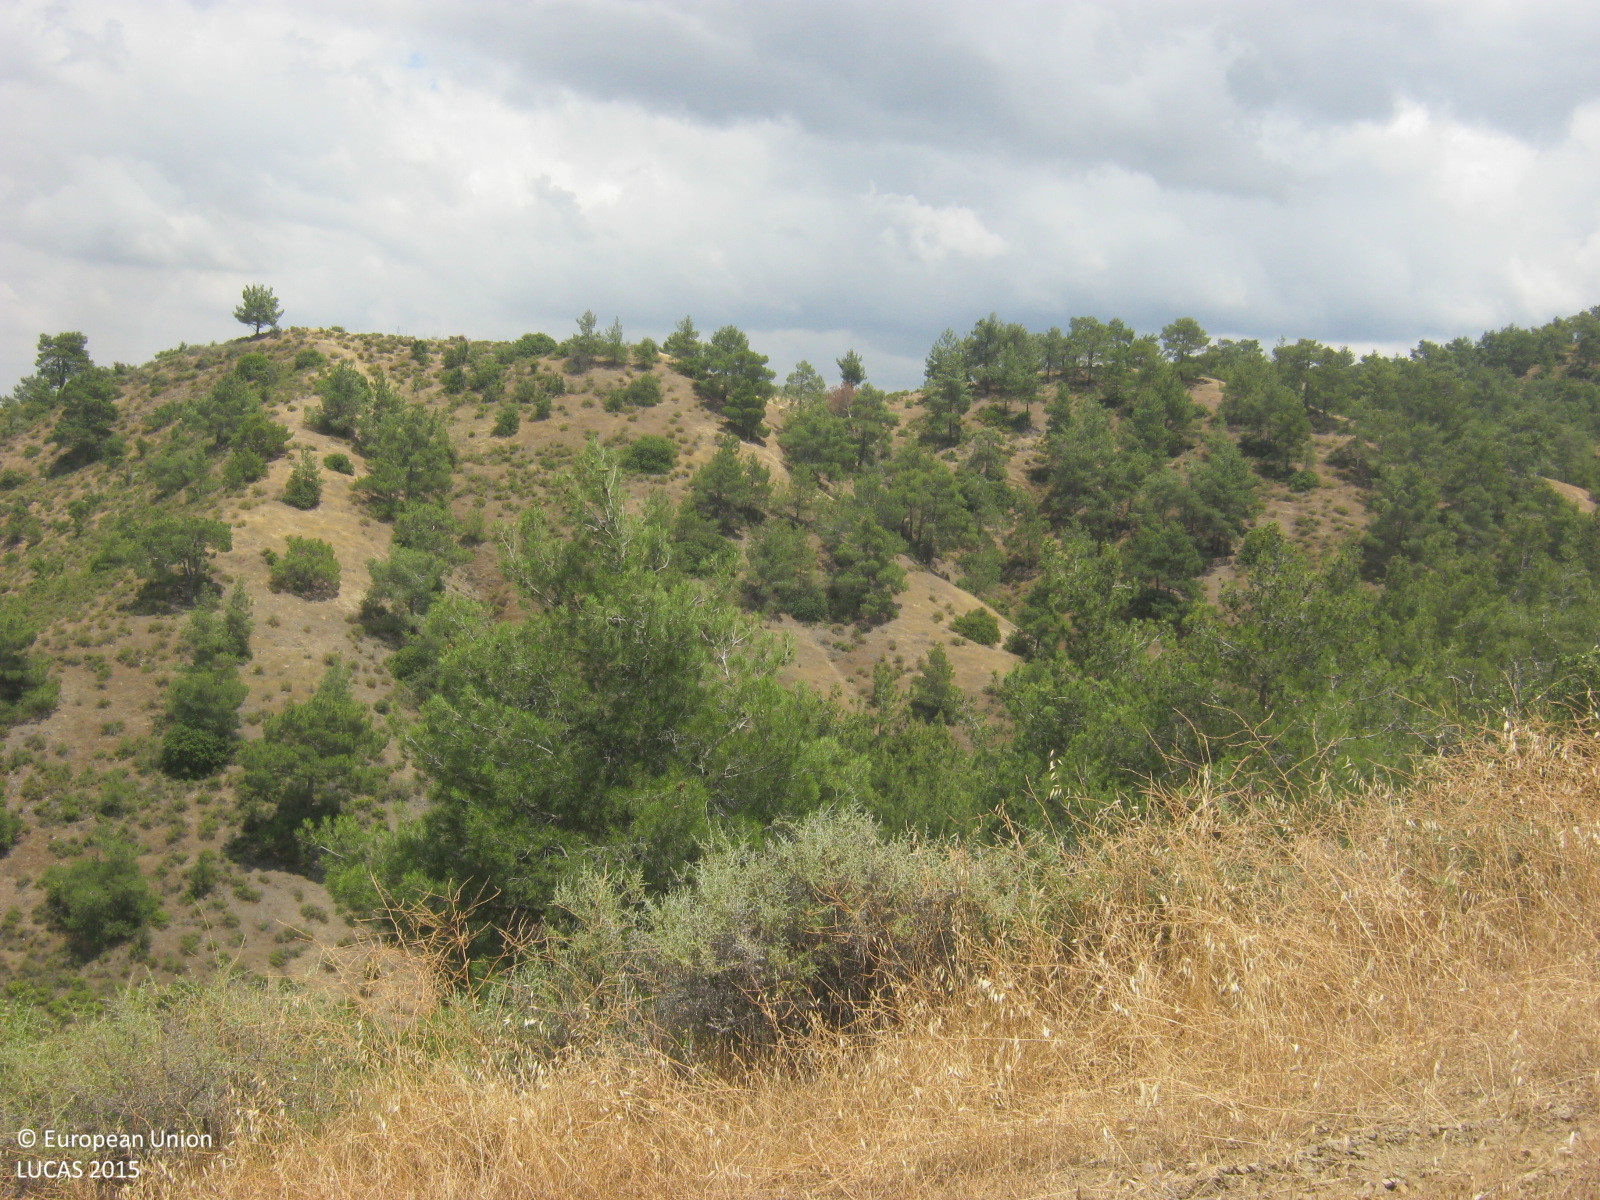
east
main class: Shrubland
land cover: Shrubland without tree cover
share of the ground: 25 - 50 %
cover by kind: herbaceous plants 50 %, shrubs 40 %, unconsolidated bare surface 10 %
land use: Semi-natural and natural areas not in use
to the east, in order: Shrubland without tree cover; Tracks; Shrubland without tree cover; Pine dominated coniferous woodland; Shrubland with sparse tree cover; Pine dominated coniferous woodland
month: June
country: CY
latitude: 35.0332
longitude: 32.8706
